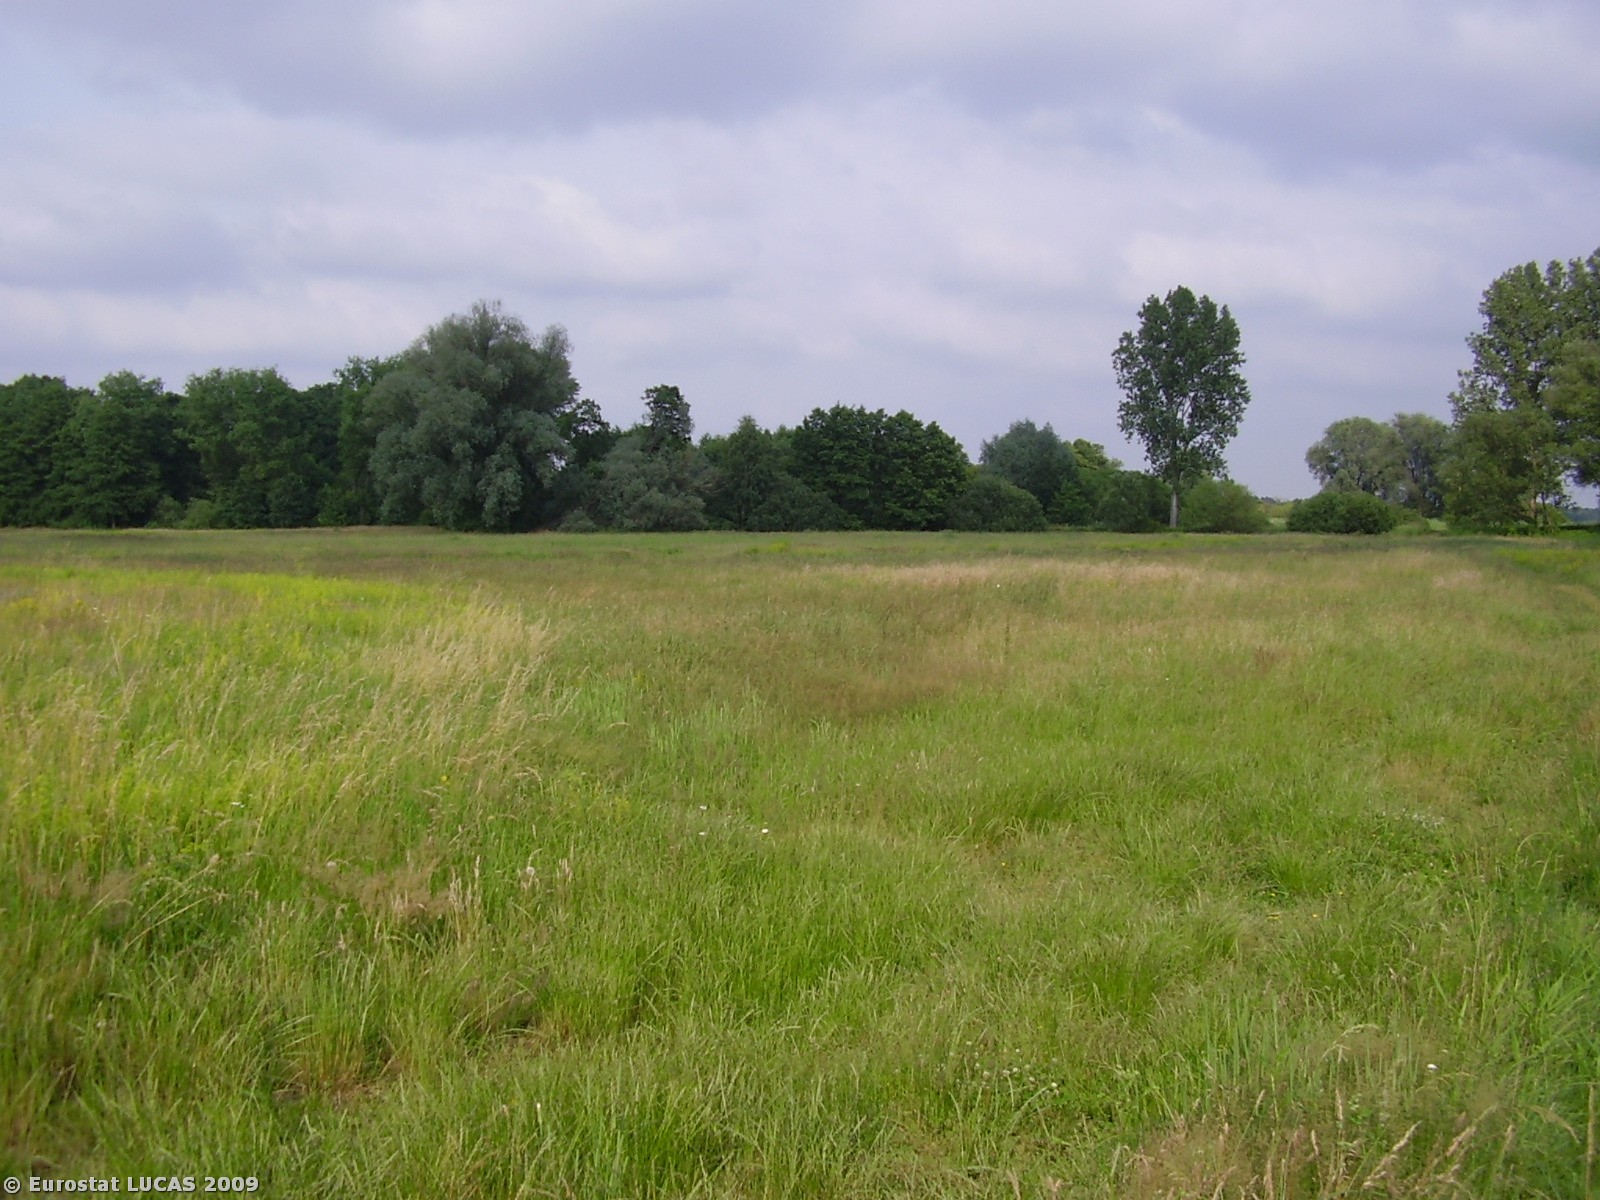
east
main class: Grassland
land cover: Grassland with sparse tree/shrub cover
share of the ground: > 75 %
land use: Unused
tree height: > 5 m
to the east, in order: Grassland with sparse tree/shrub cover; Broadleaved woodland; Paved roads, cycling and walking lanes; Broadleaved woodland; Grassland without tree/shrub cover
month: June
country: PL
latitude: 51.7129
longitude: 16.1575
